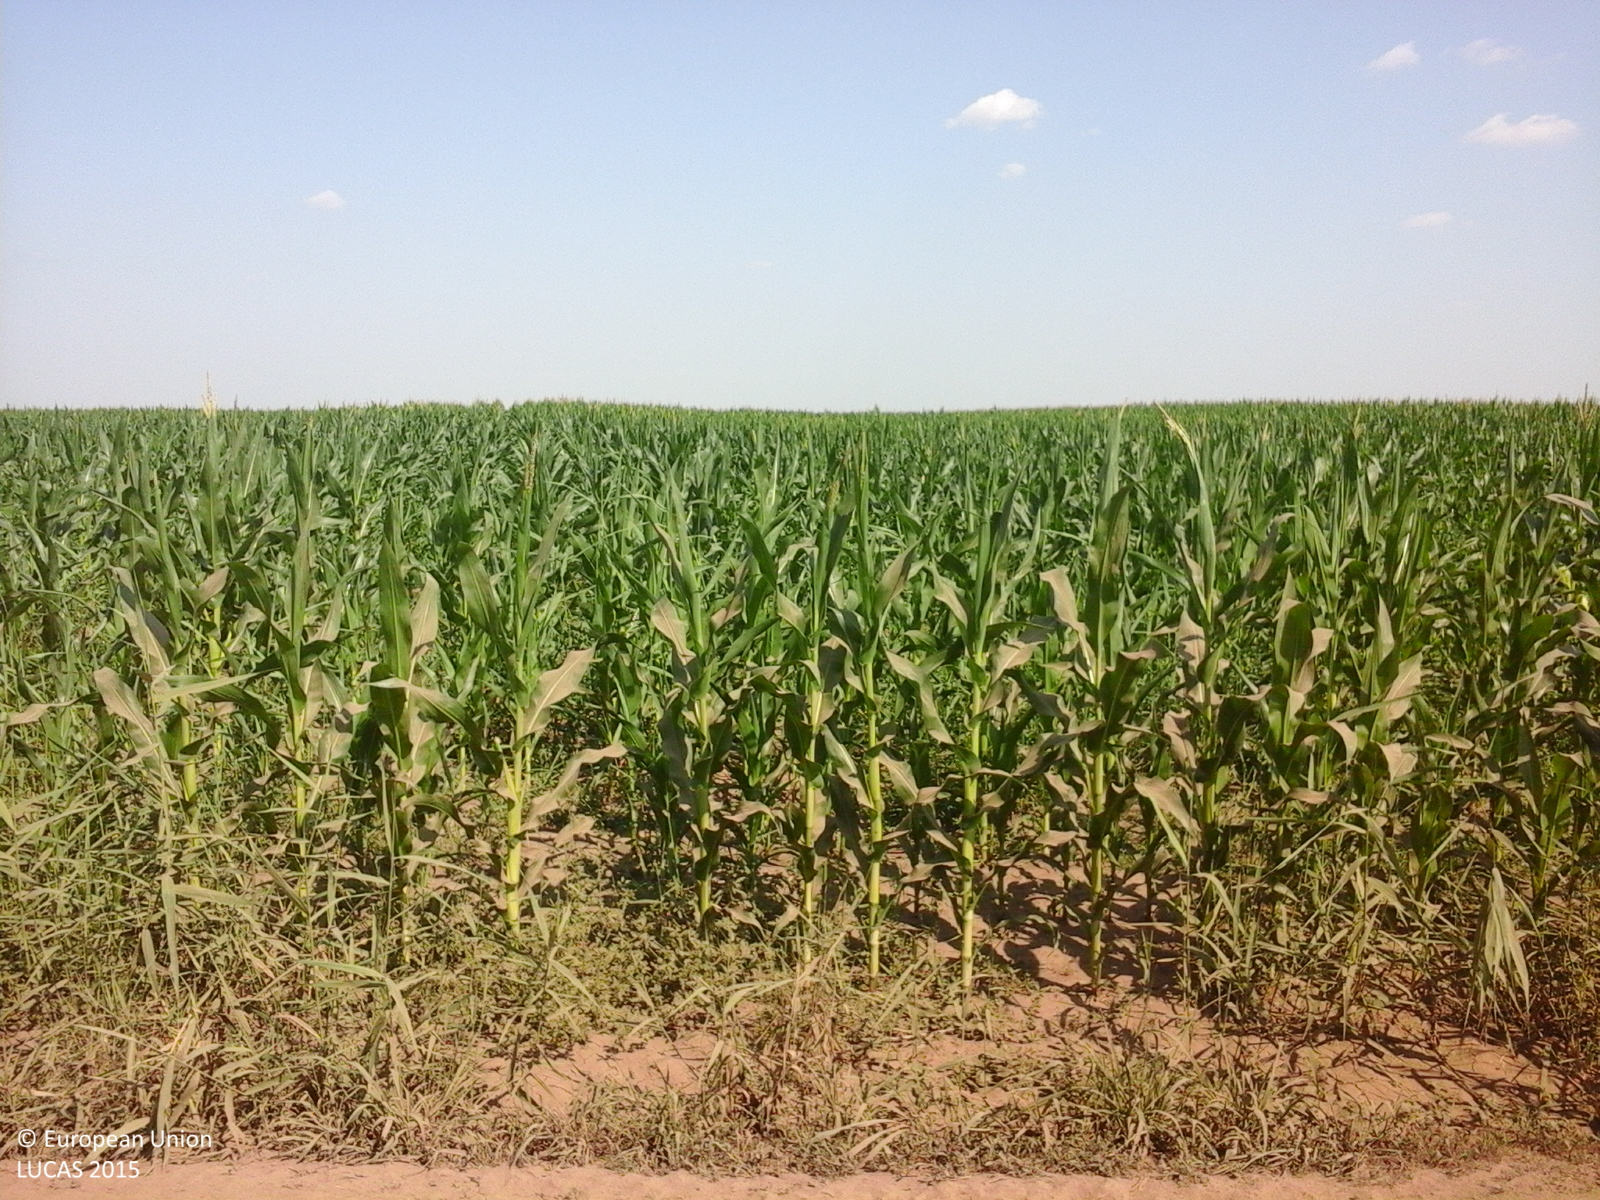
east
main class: Cropland
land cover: Maize
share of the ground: > 75 %
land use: Agriculture (excluding fallow land and kitchen gardens)
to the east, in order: Maize
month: July
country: RO
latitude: 45.0443
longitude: 26.9290
